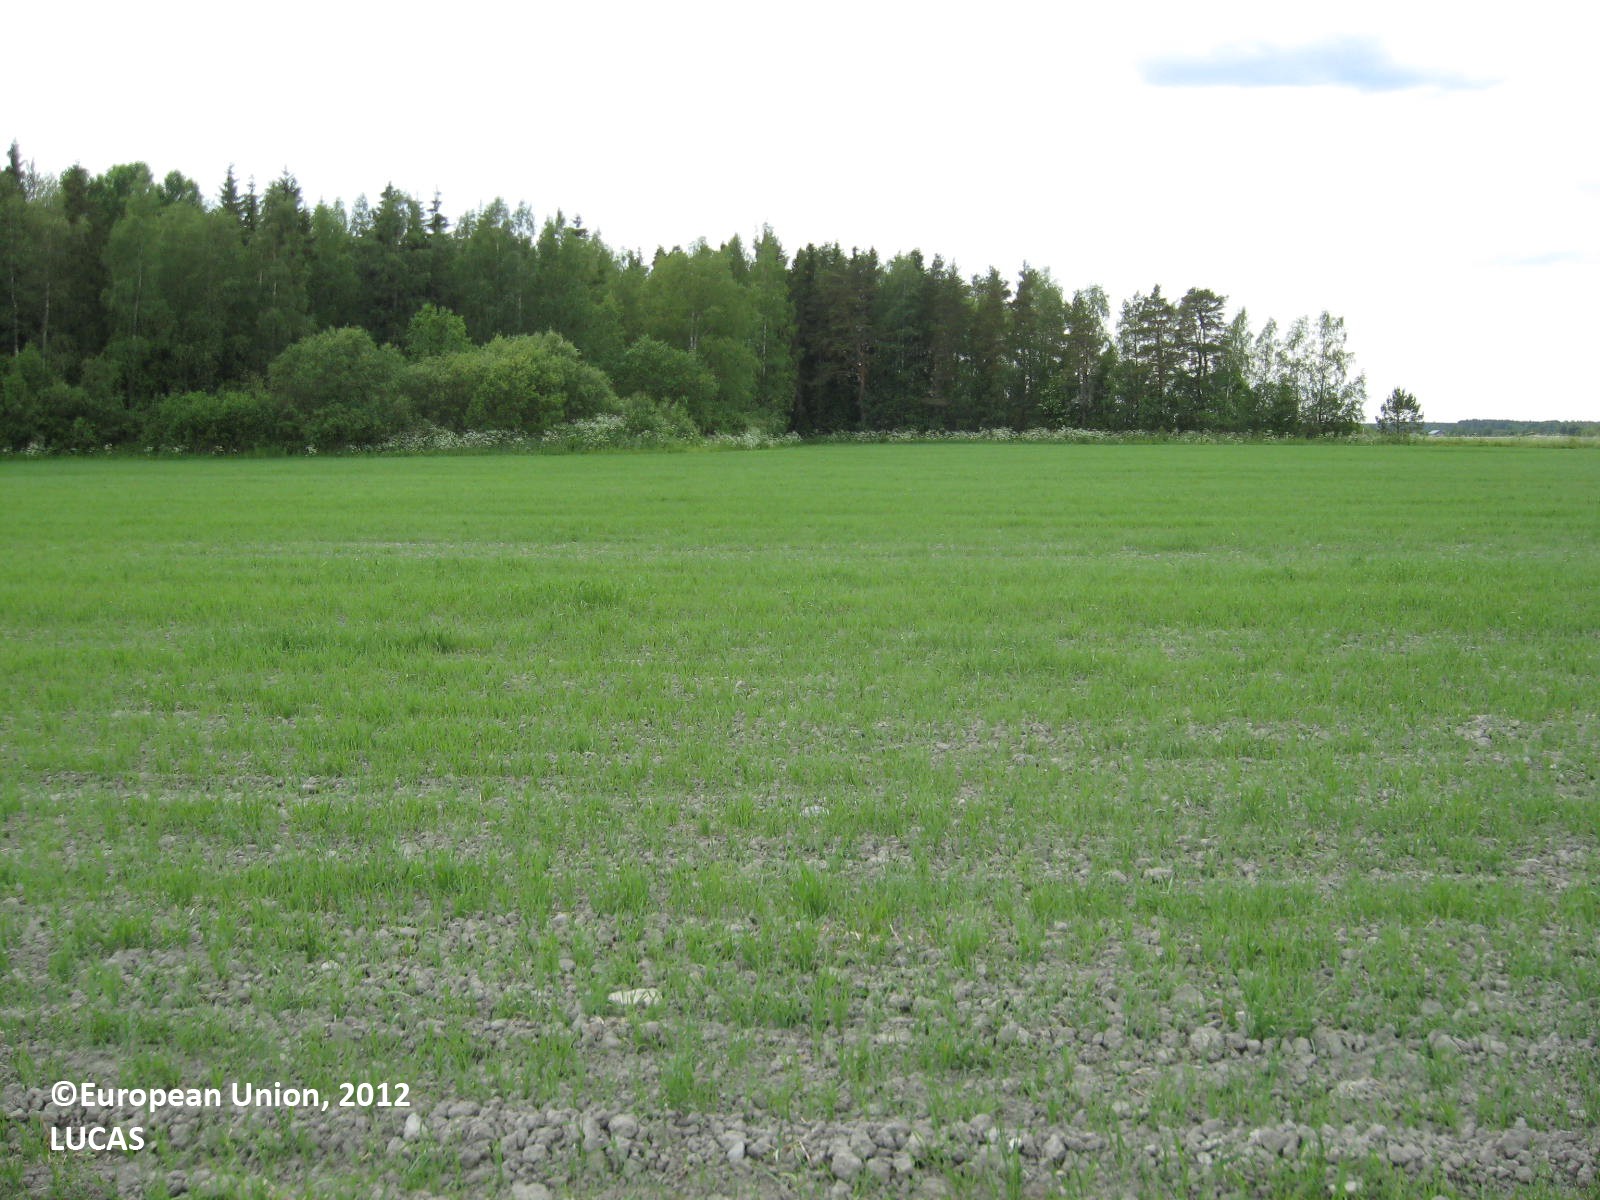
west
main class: Cropland
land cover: Oats
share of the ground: 50 - 75 %
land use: Agriculture (excluding fallow land and kitchen gardens)
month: June
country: FI
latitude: 62.6248
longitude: 21.5247
